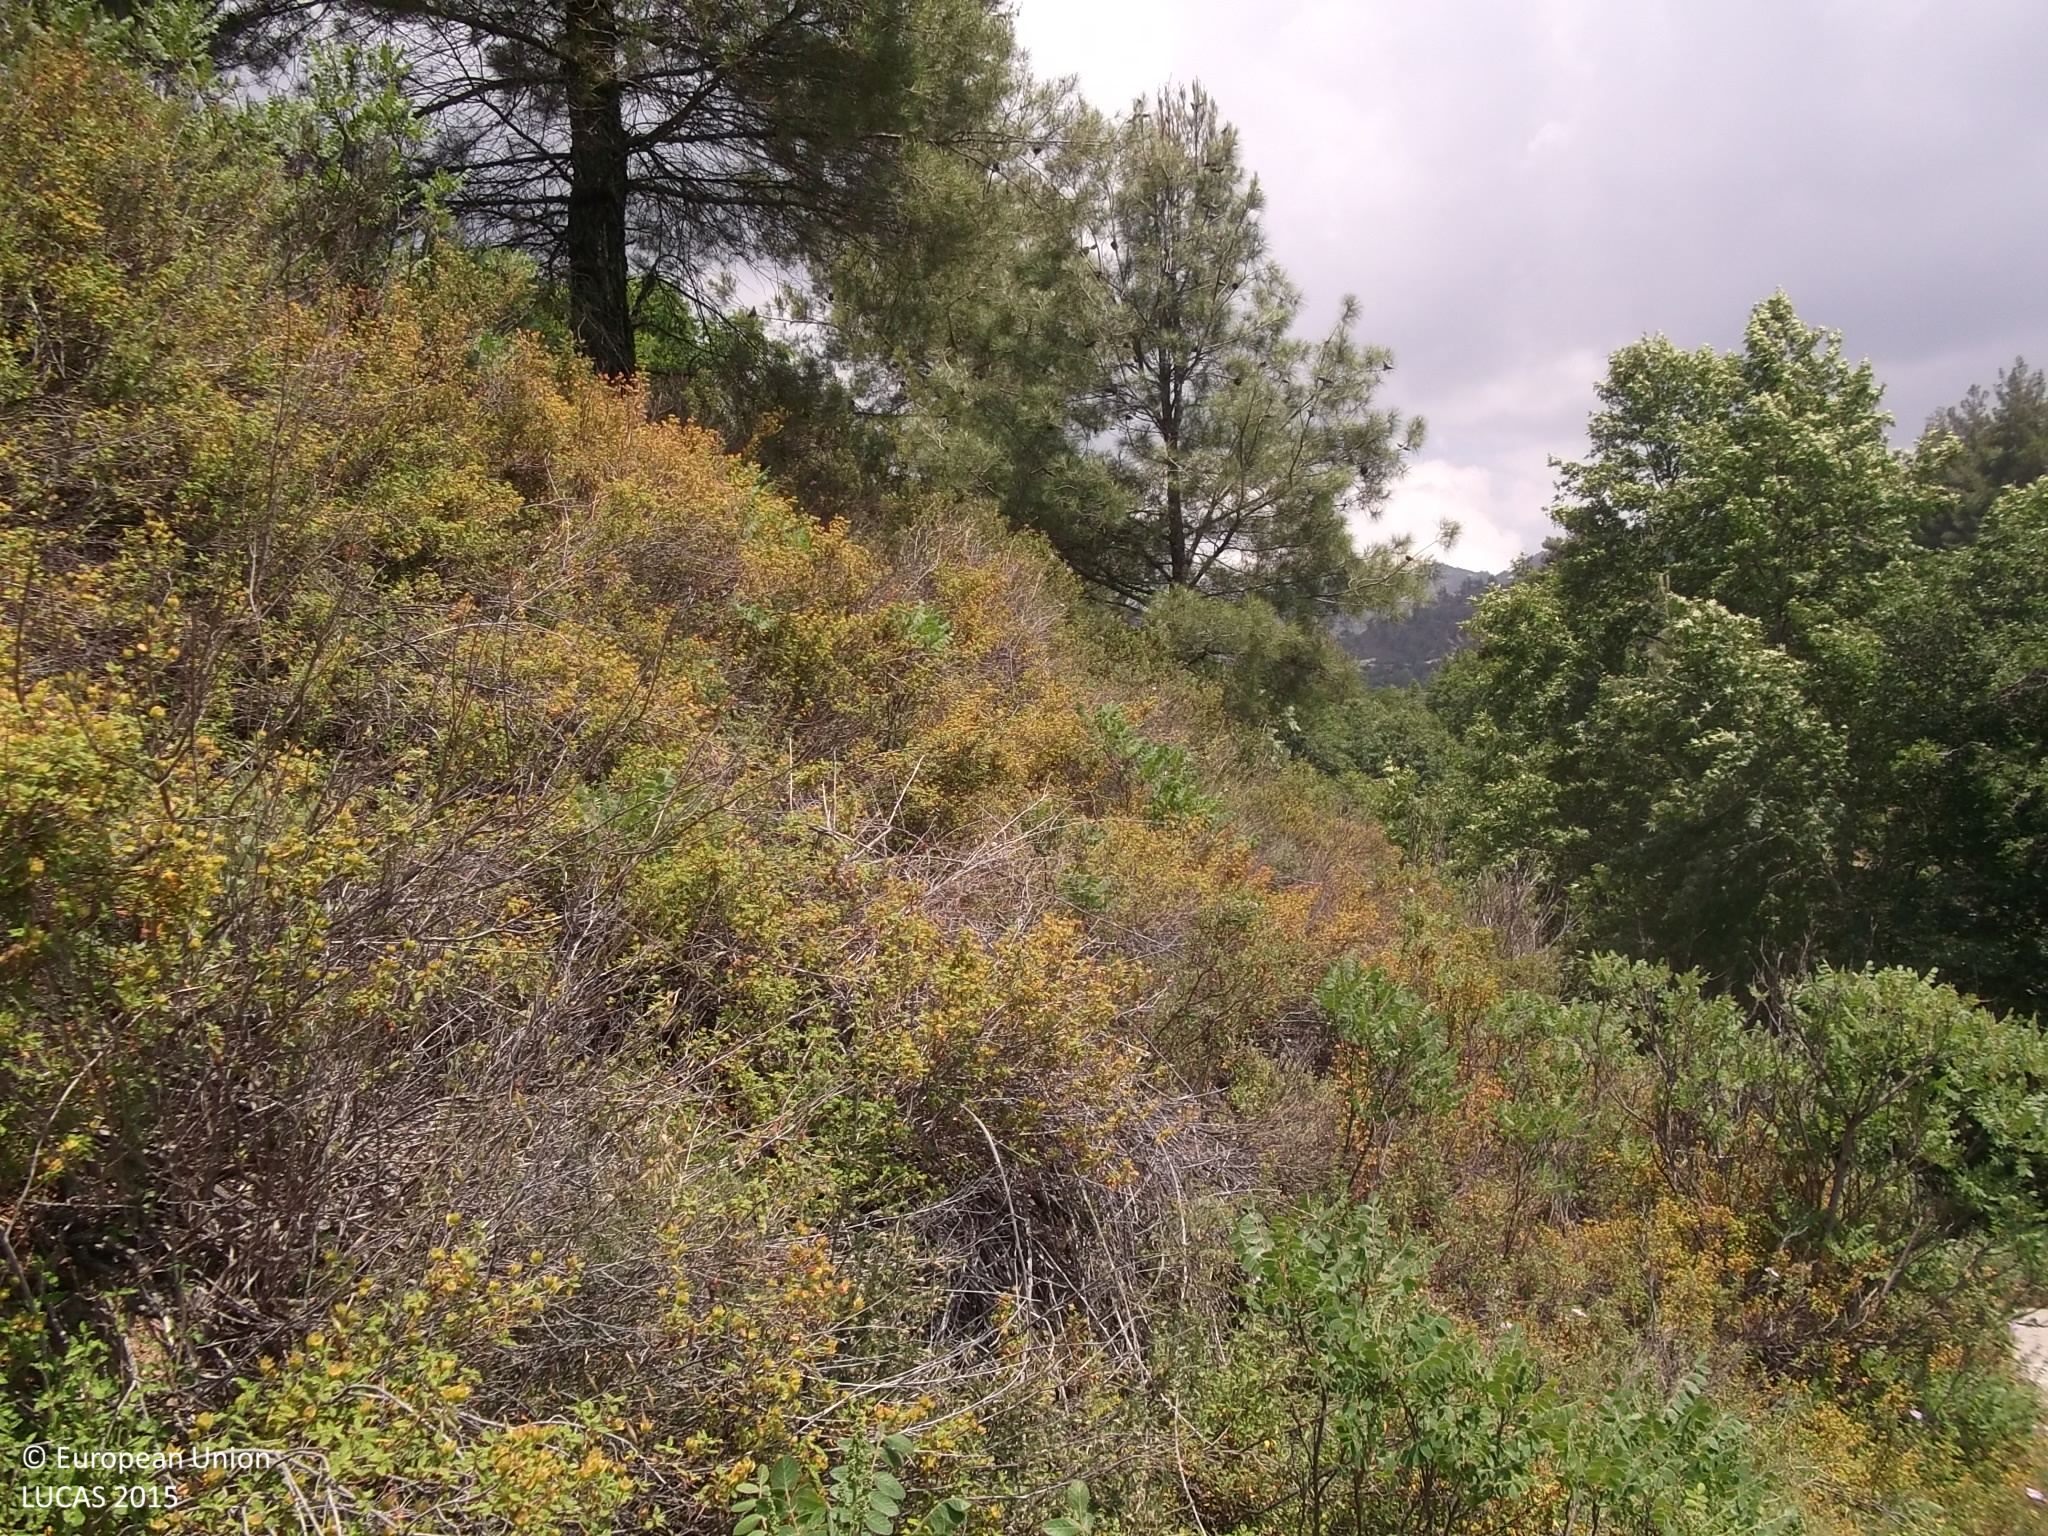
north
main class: Shrubland
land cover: Shrubland with sparse tree cover
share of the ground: > 75 %
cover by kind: shrubs 95 %, coniferous forest trees 5 %
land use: Semi-natural and natural areas not in use
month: June
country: CY
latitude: 34.9024
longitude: 32.9424
